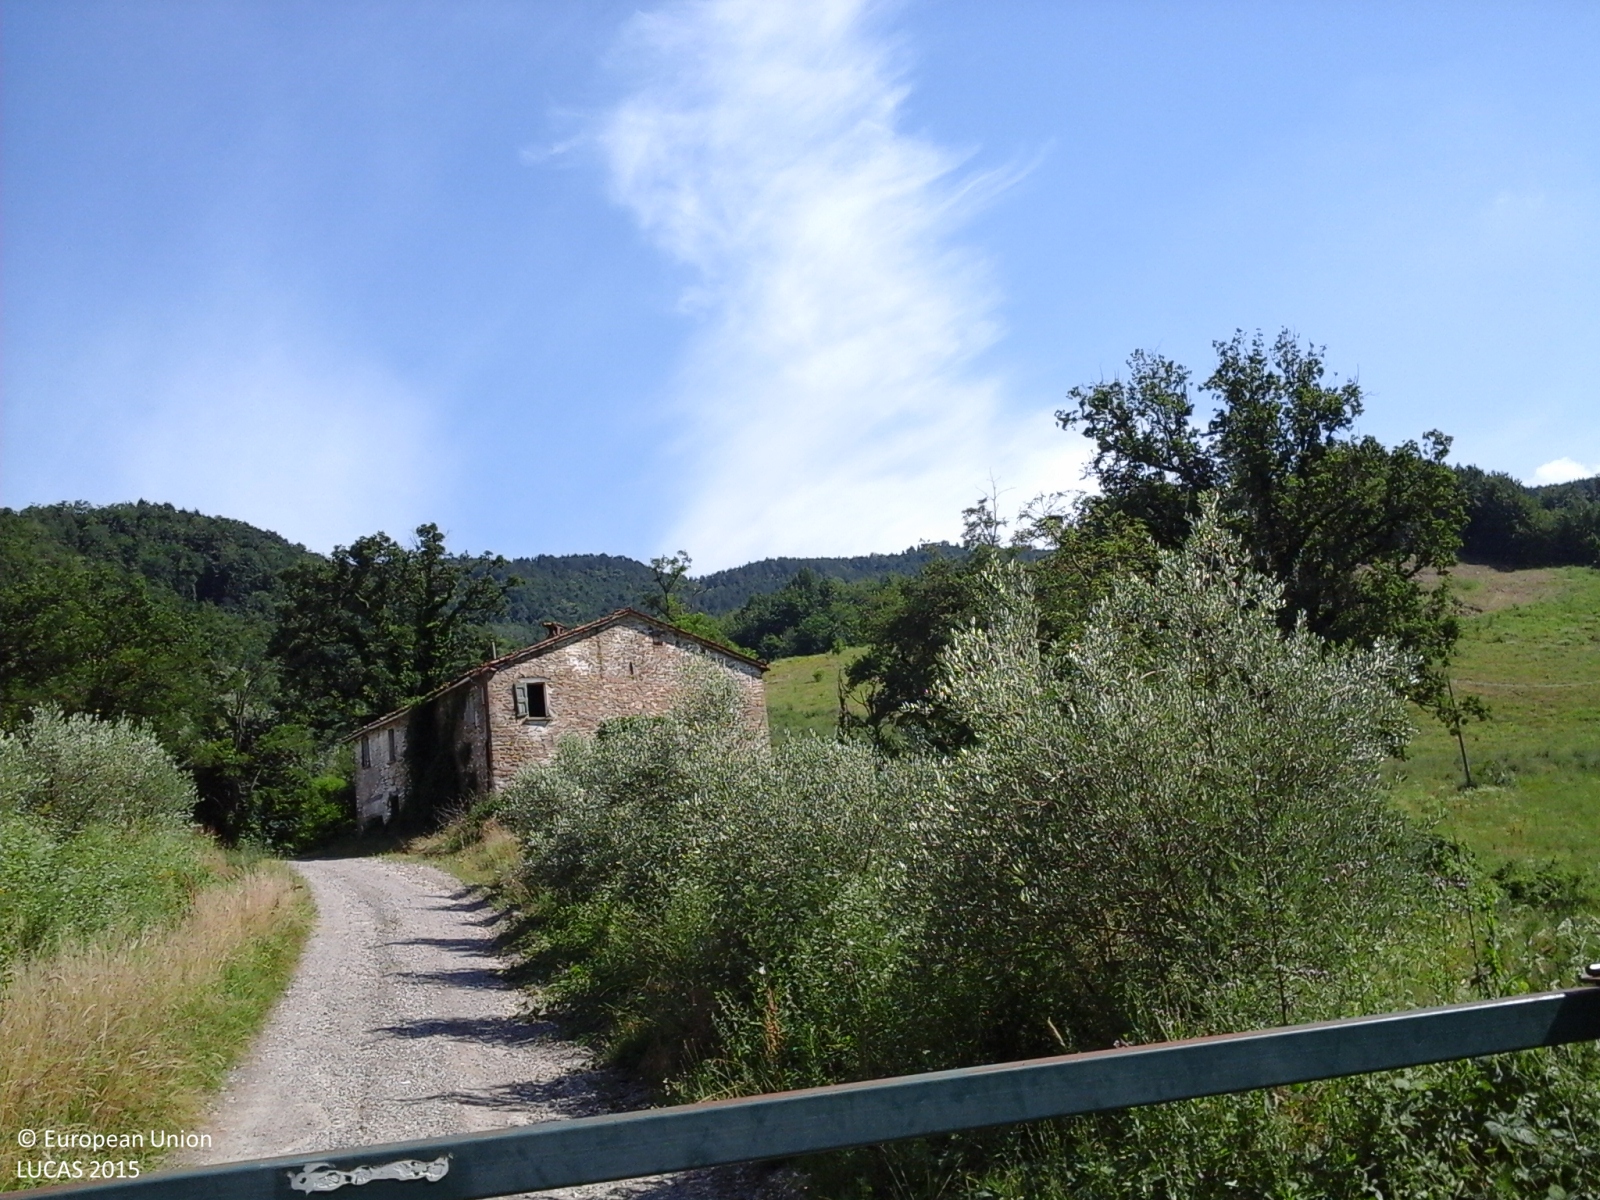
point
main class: Woodland
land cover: Pine dominated mixed woodland
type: coniferous forest of the mediterranean region
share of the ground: > 75 %
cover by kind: coniferous forest trees 60 %, broadleaved forest trees 40 %
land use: Forestry
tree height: > 5 m
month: June
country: IT
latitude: 44.2106
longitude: 11.6857
